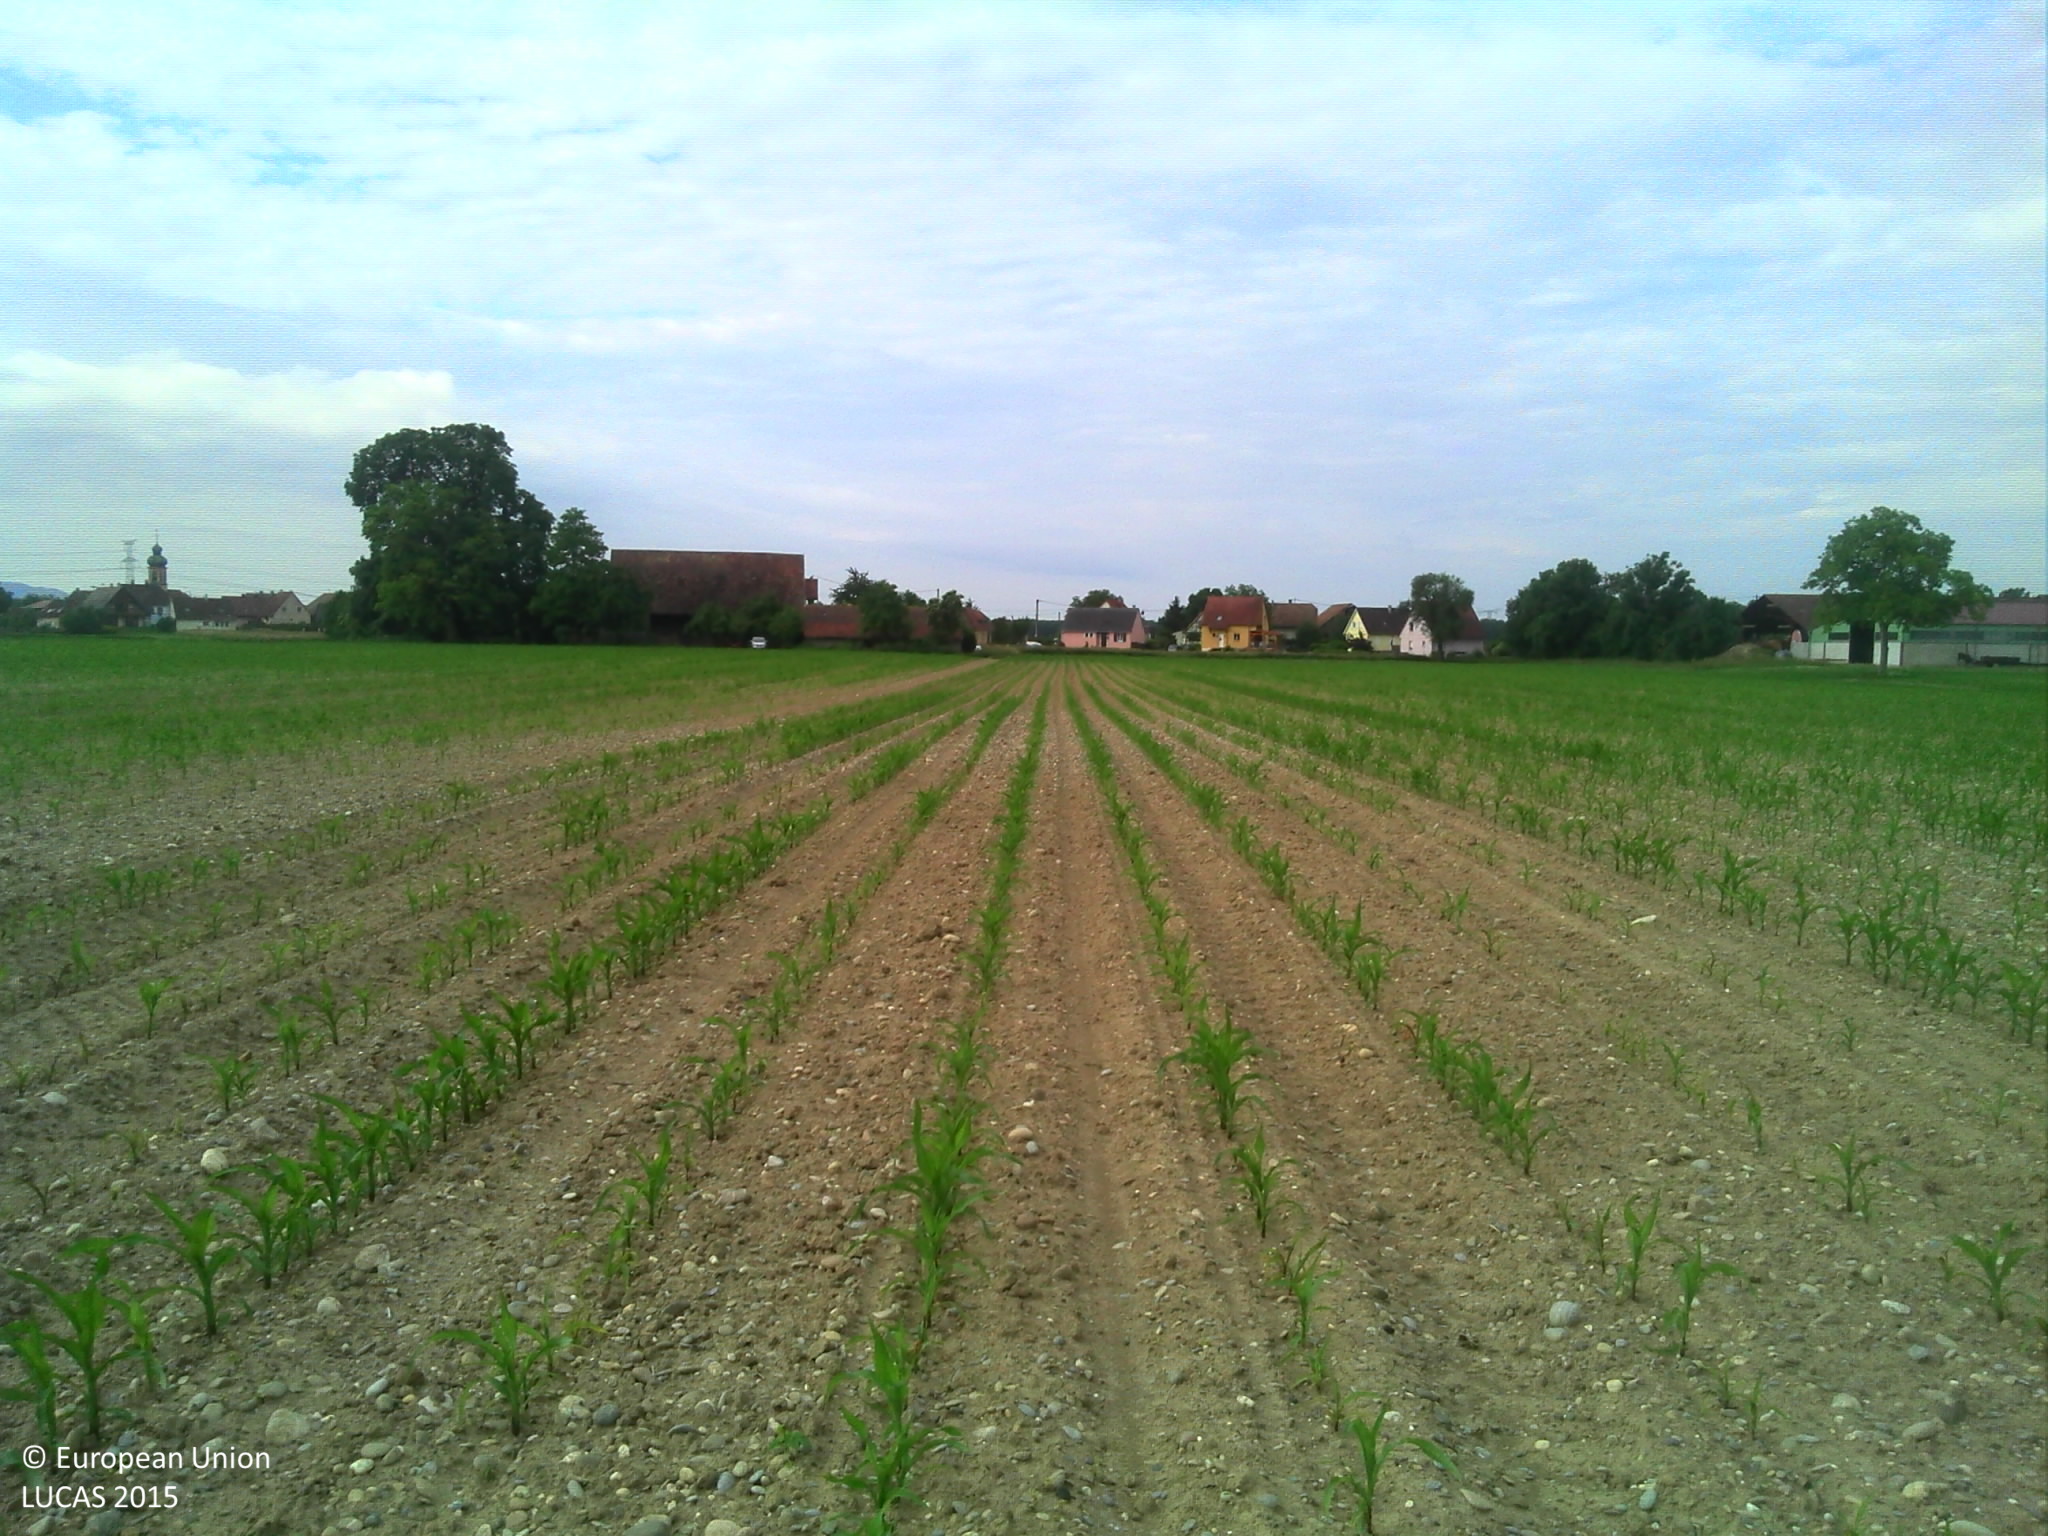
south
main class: Cropland
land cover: Maize
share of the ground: < 10 %
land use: Agriculture (excluding fallow land and kitchen gardens)
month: June
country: FR
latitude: 47.9815
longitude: 7.6030
